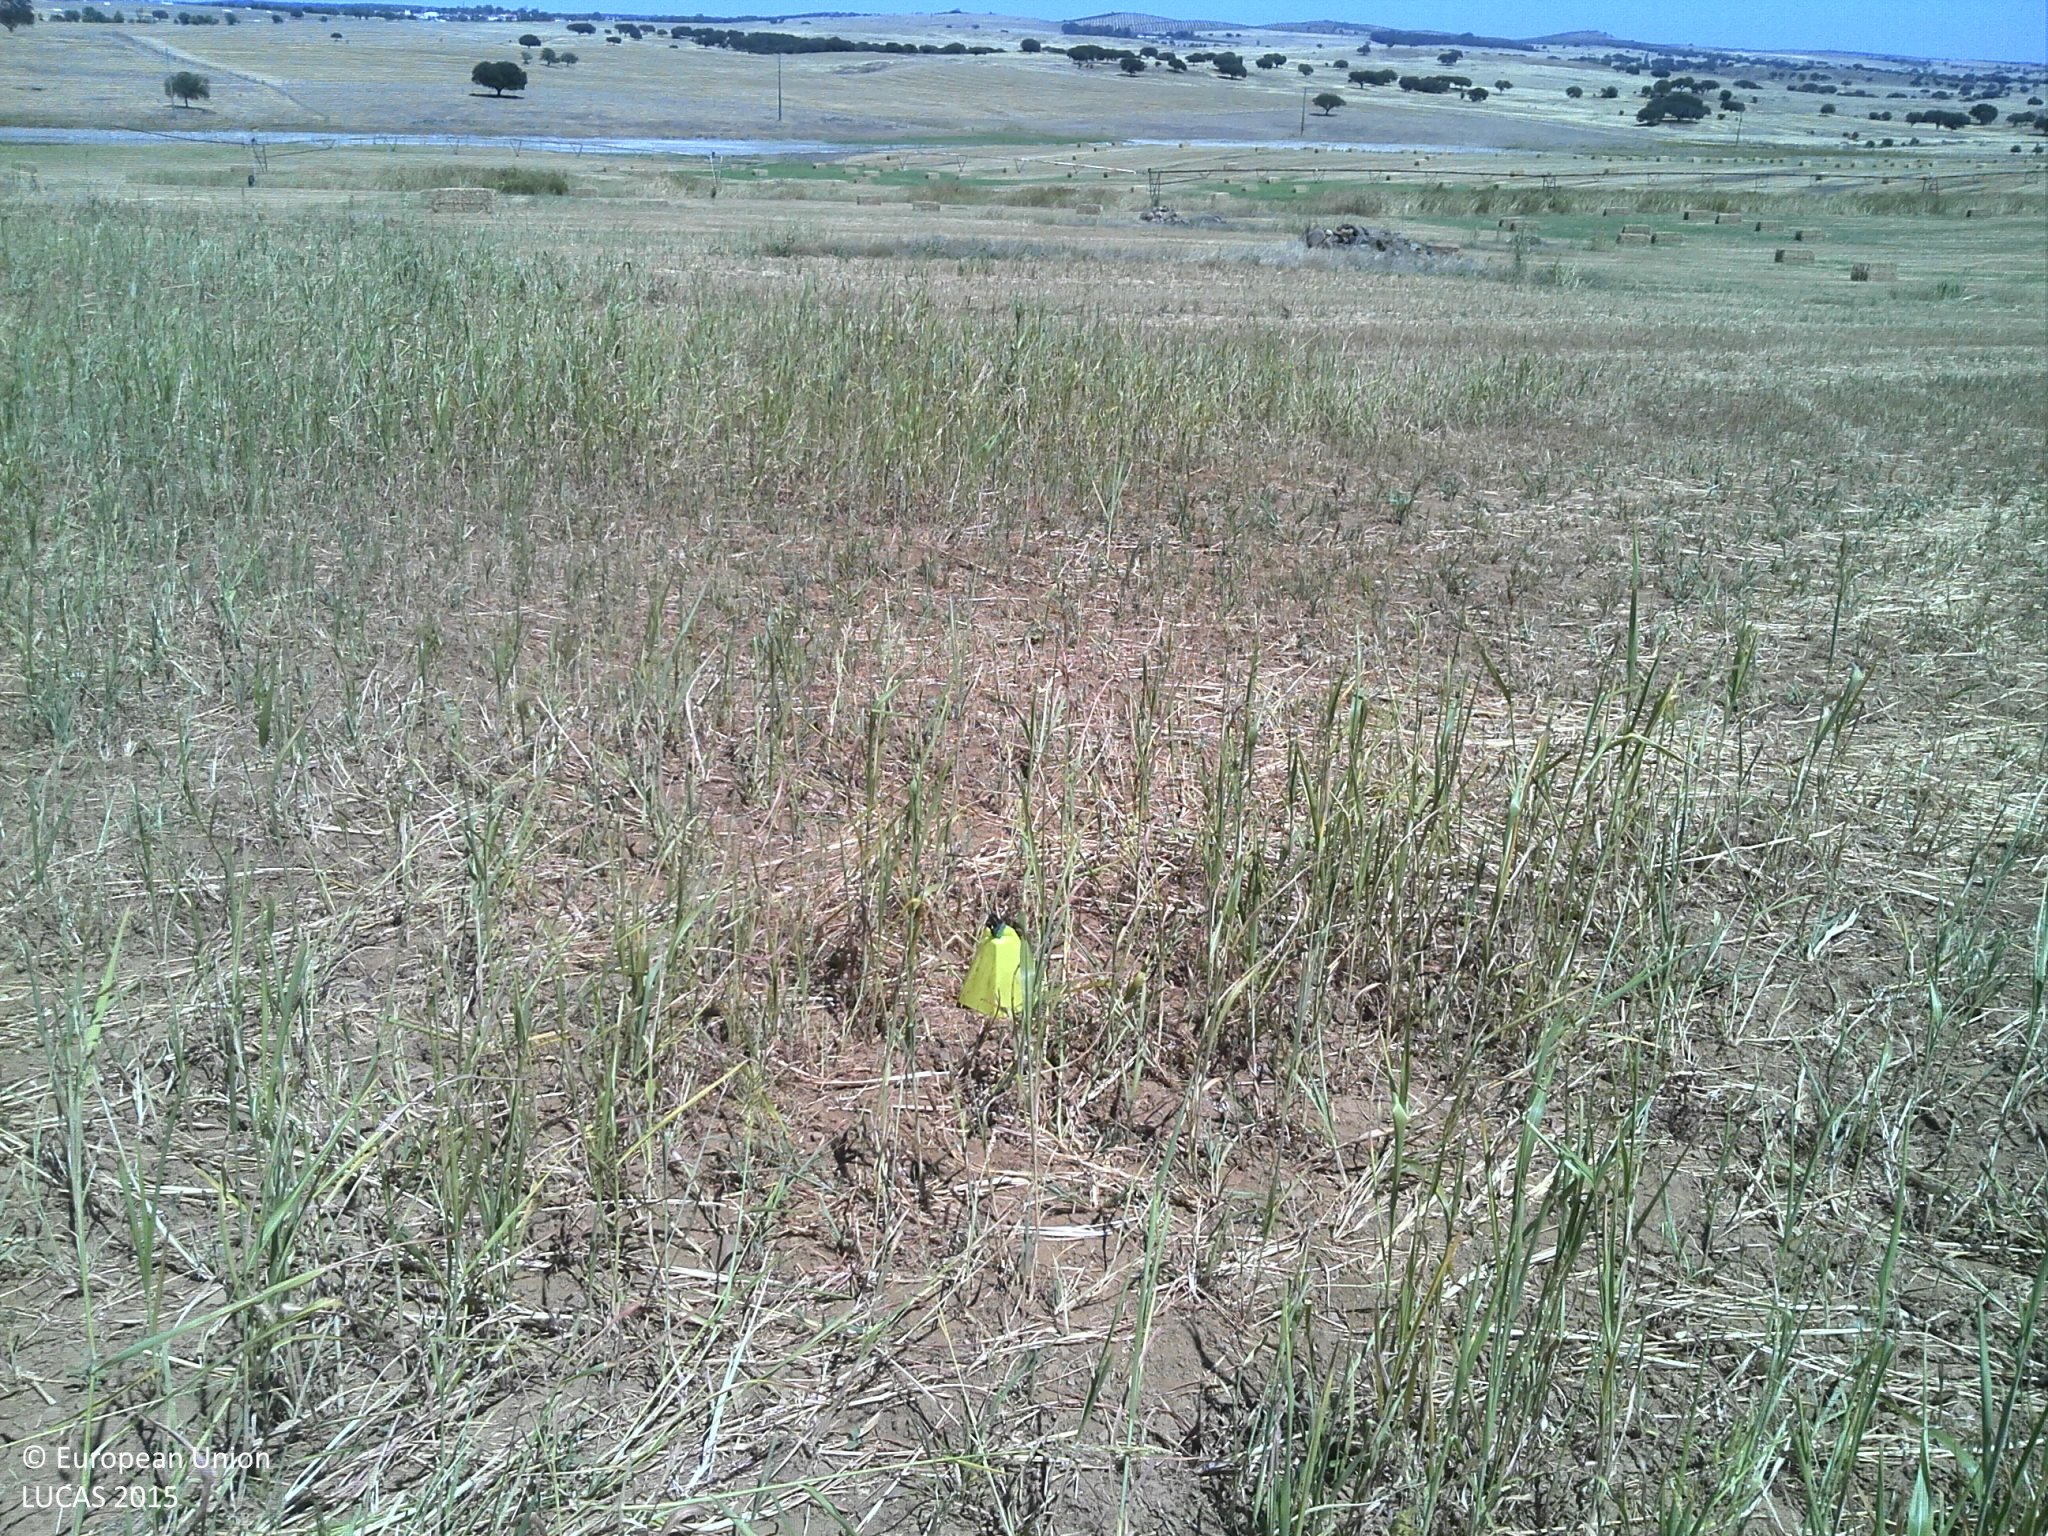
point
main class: Cropland
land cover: Other cereals
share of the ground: 10 - 25 %
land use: Agriculture (excluding fallow land and kitchen gardens)
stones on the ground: < 10 %
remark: Harvested field
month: July
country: PT
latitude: 38.9084
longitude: -7.3653
